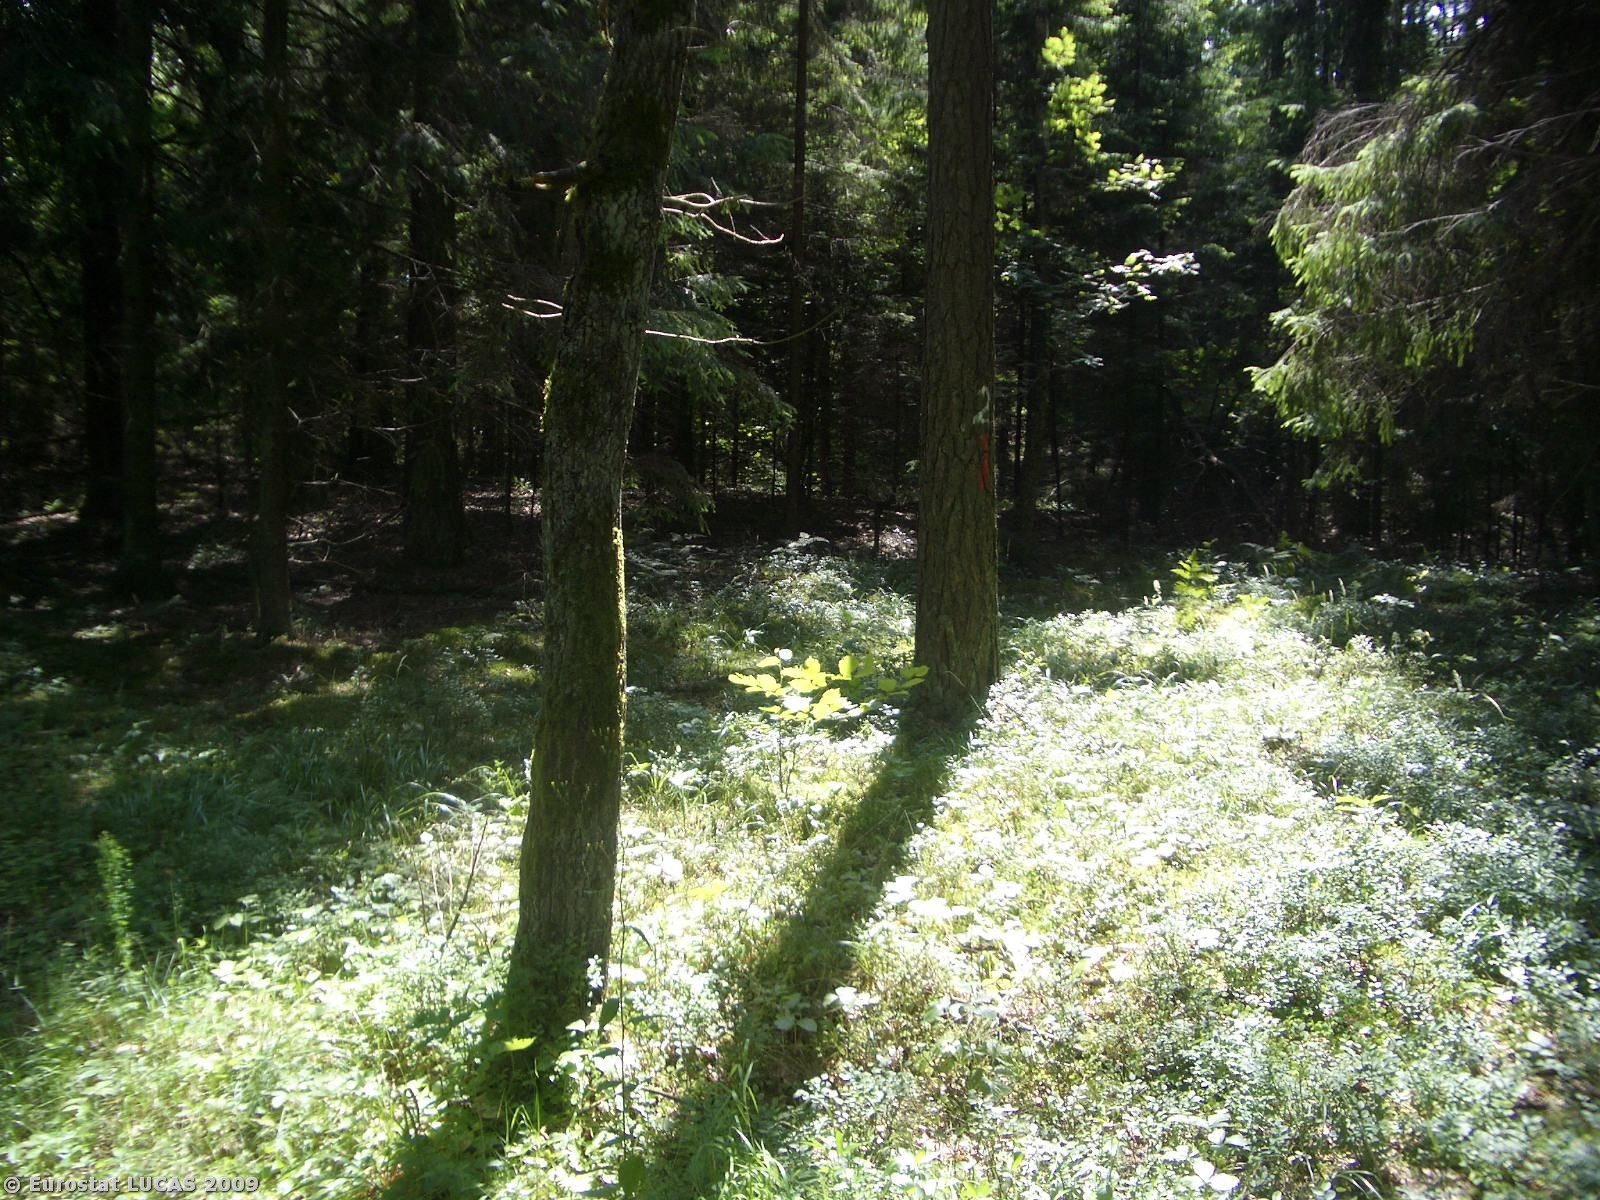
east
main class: Woodland
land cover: Mixed woodland
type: hemiboreal forest and nemoral coniferous forest and mixed broadleaved-coniferous forest
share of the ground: > 75 %
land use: Forestry
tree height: > 5 m
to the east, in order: Mixed woodland
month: July
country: PL
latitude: 54.0124
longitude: 23.3098
